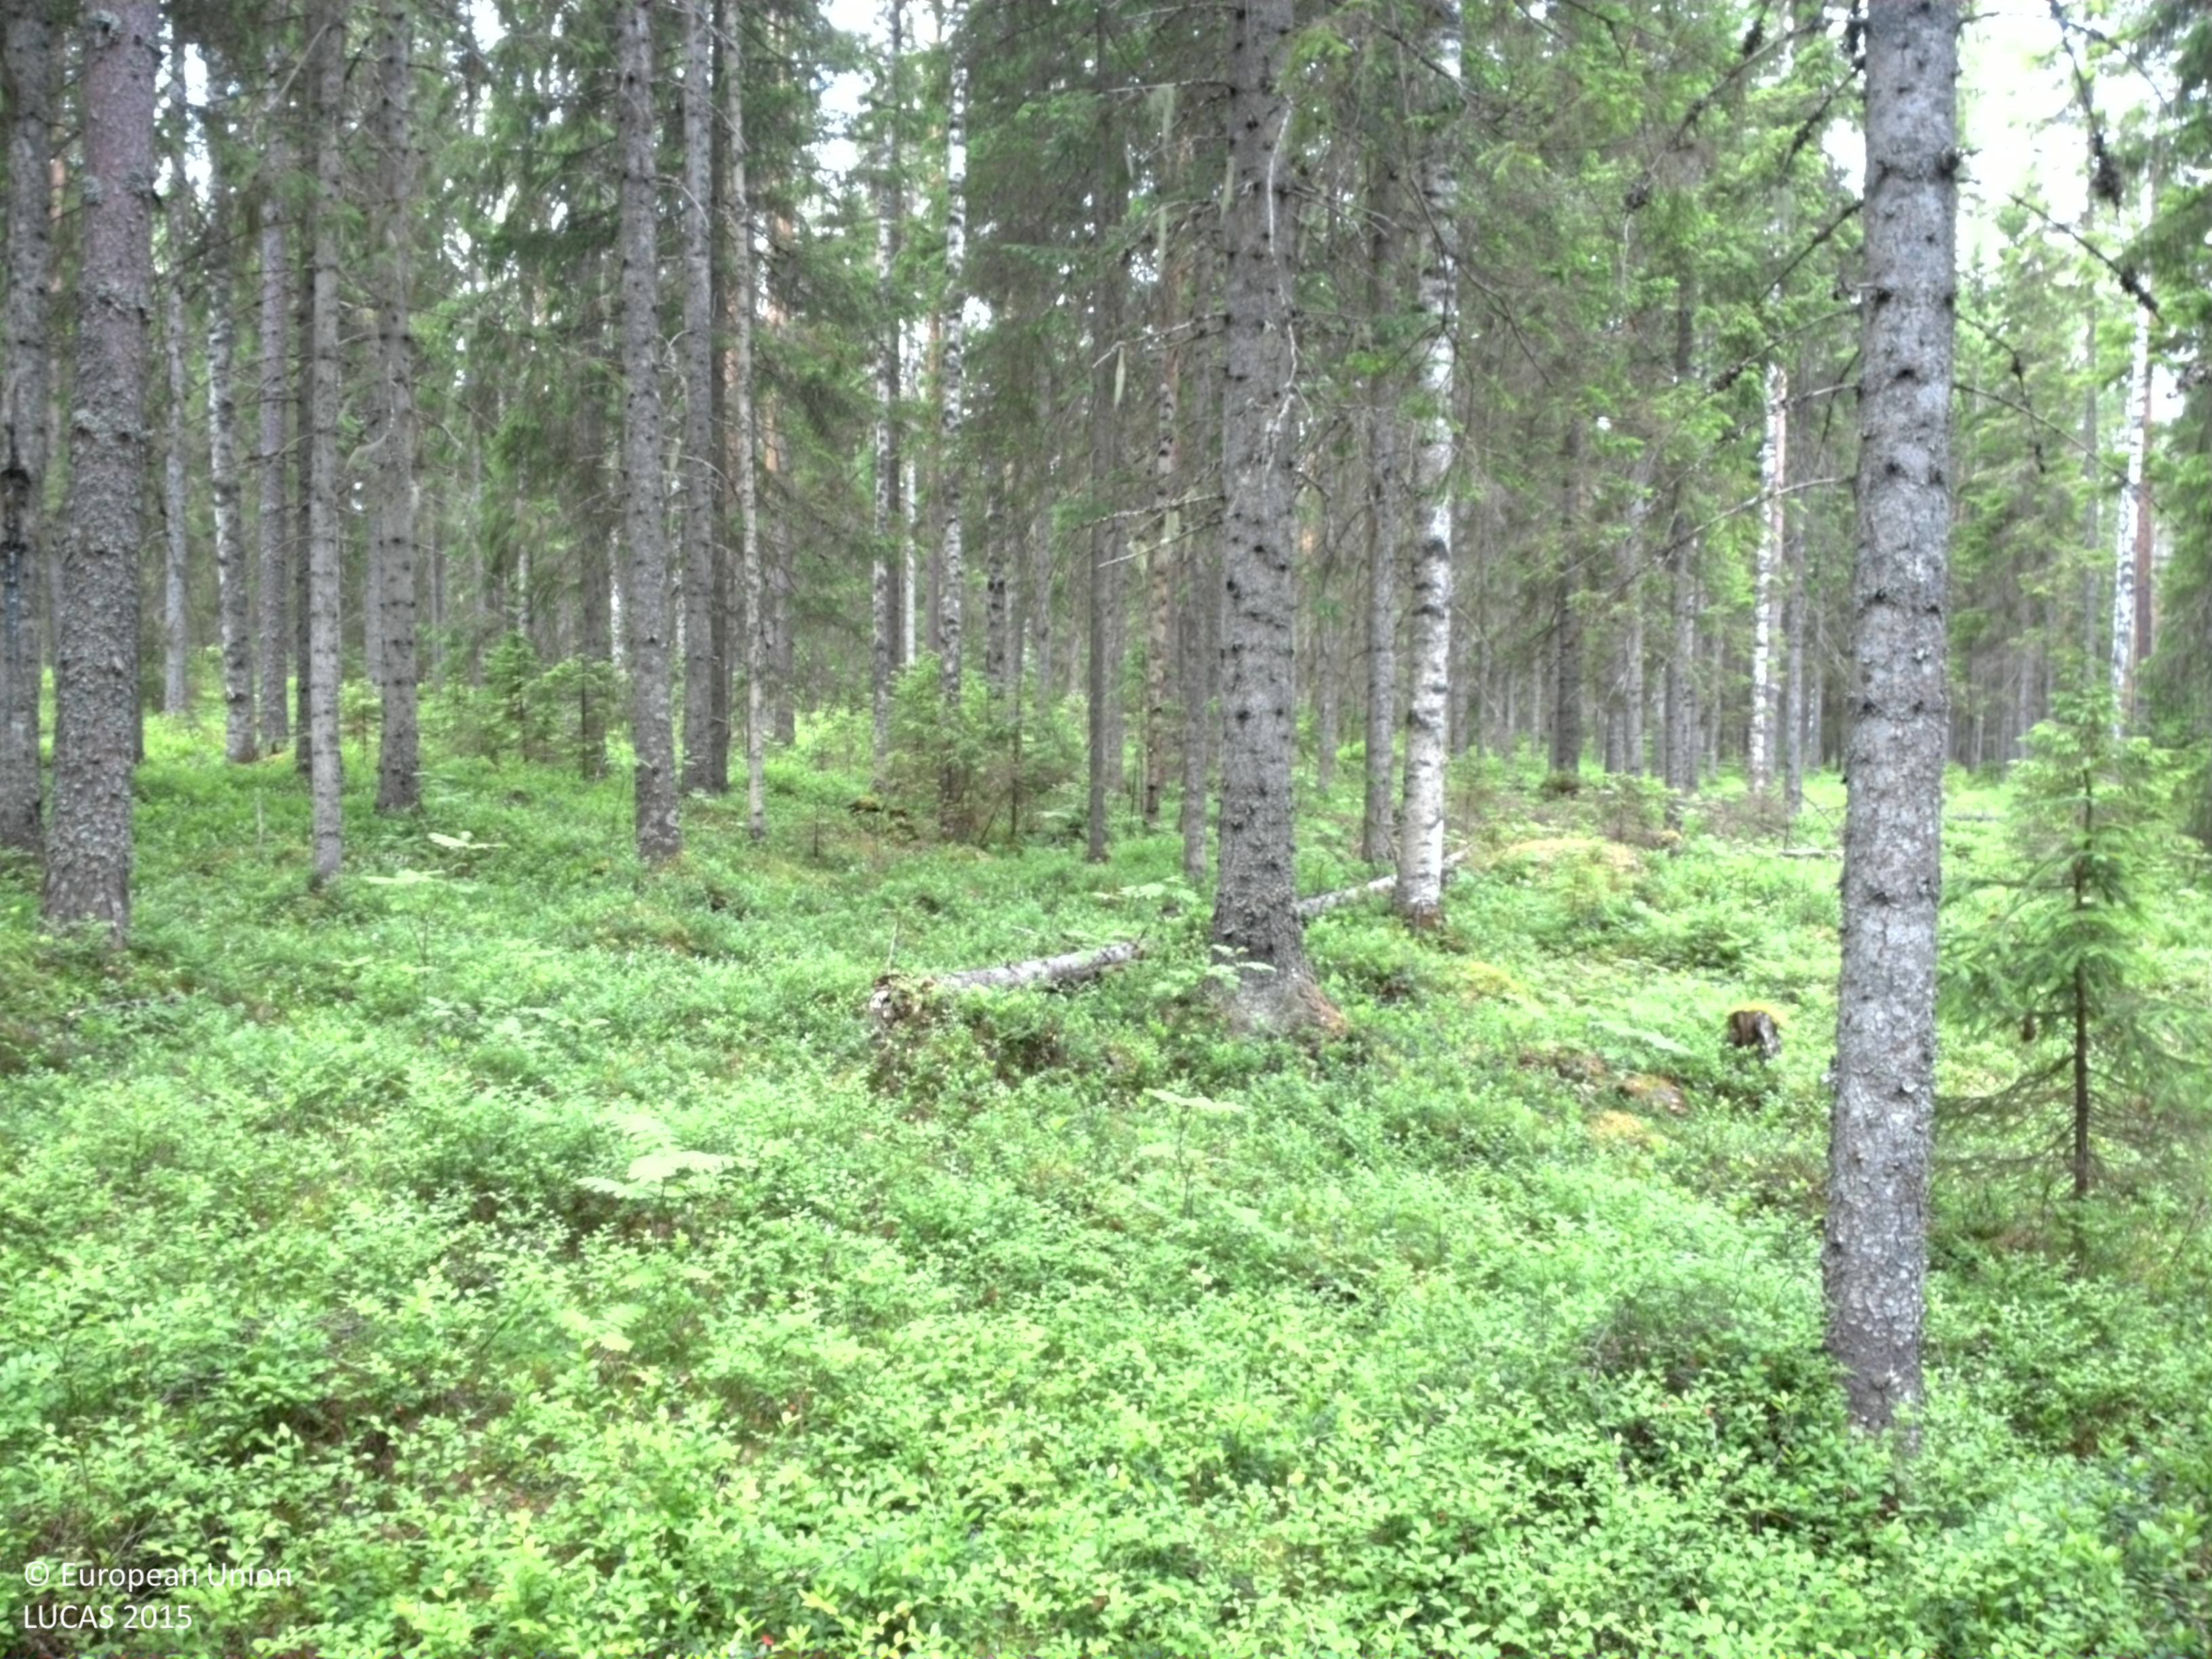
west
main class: Woodland
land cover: Spruce dominated coniferous woodland
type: boreal forest
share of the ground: 50 - 75 %
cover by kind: coniferous forest trees 75 %, shrubs 25 %
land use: Forestry
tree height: > 5 m
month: July
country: SE
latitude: 64.4606
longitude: 20.8944
